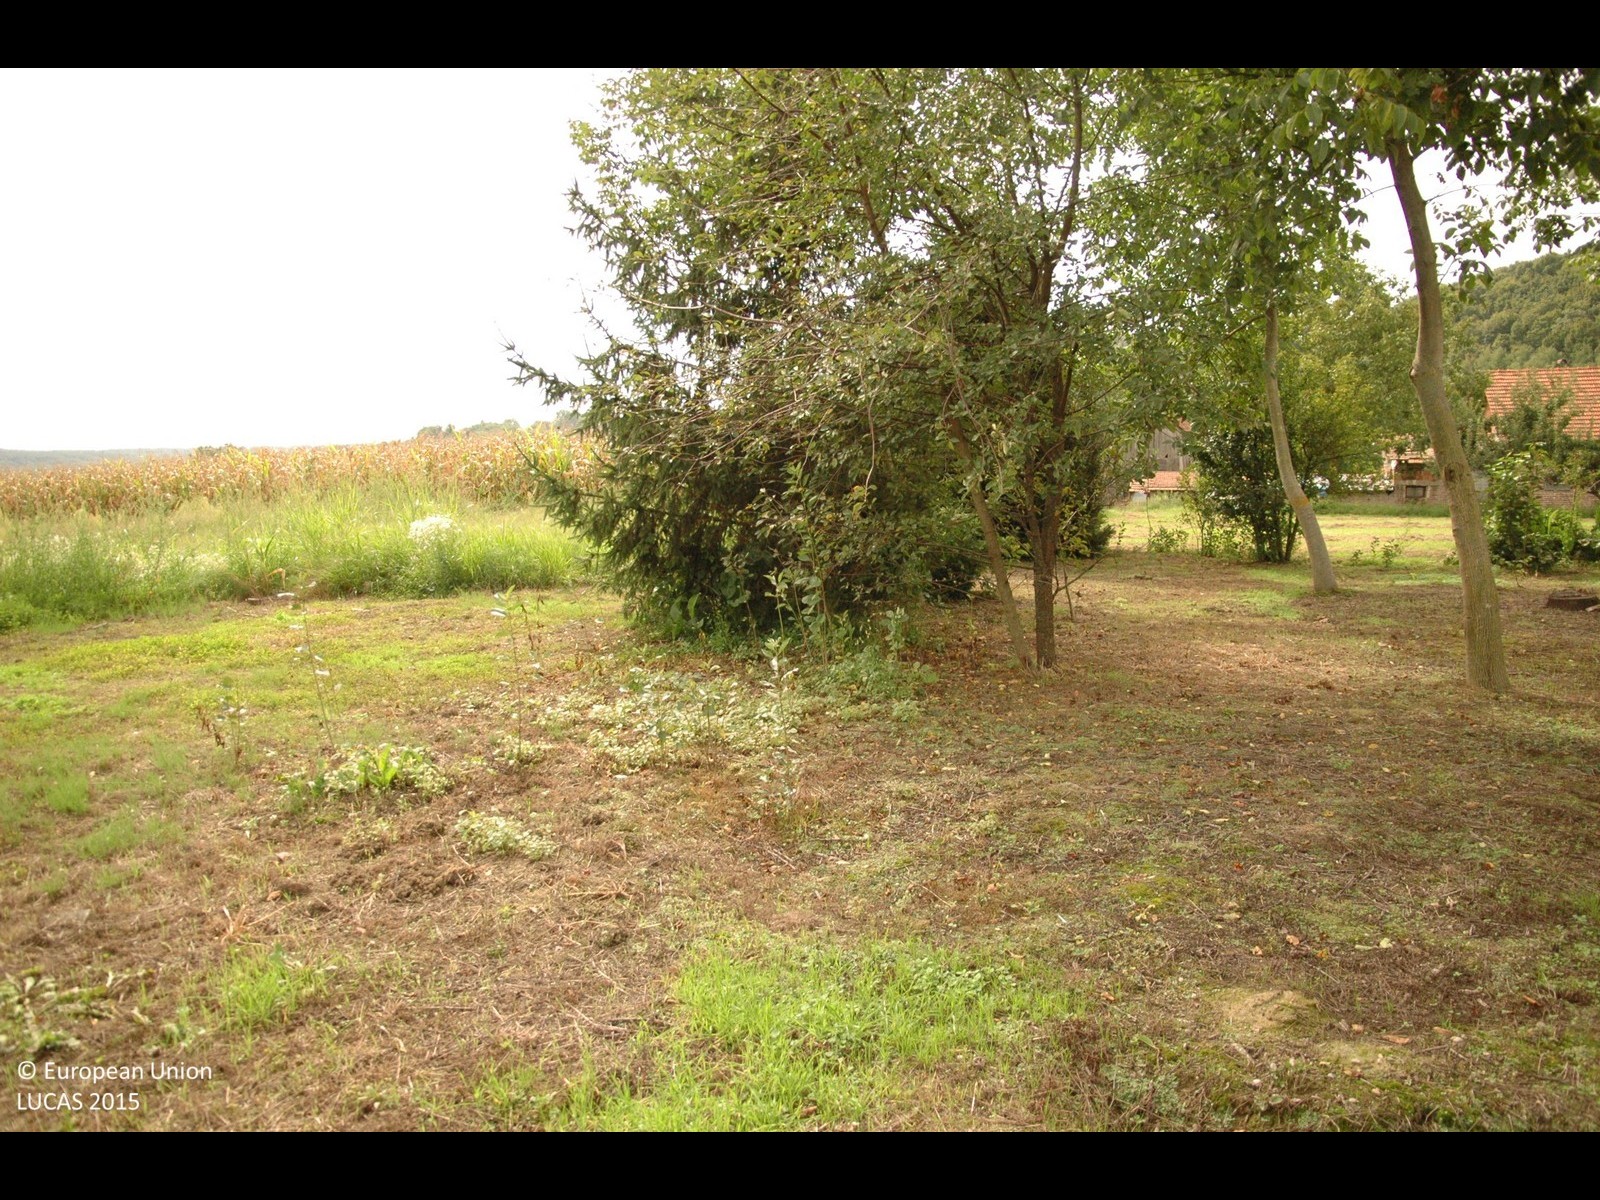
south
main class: Grassland
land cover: Grassland with sparse tree/shrub cover
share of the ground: > 75 %
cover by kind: herbaceous plants 95 %, broadleaved forest trees 5 %
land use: Agriculture (excluding fallow land and kitchen gardens)
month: September
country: HR
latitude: 46.0729
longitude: 16.9185
